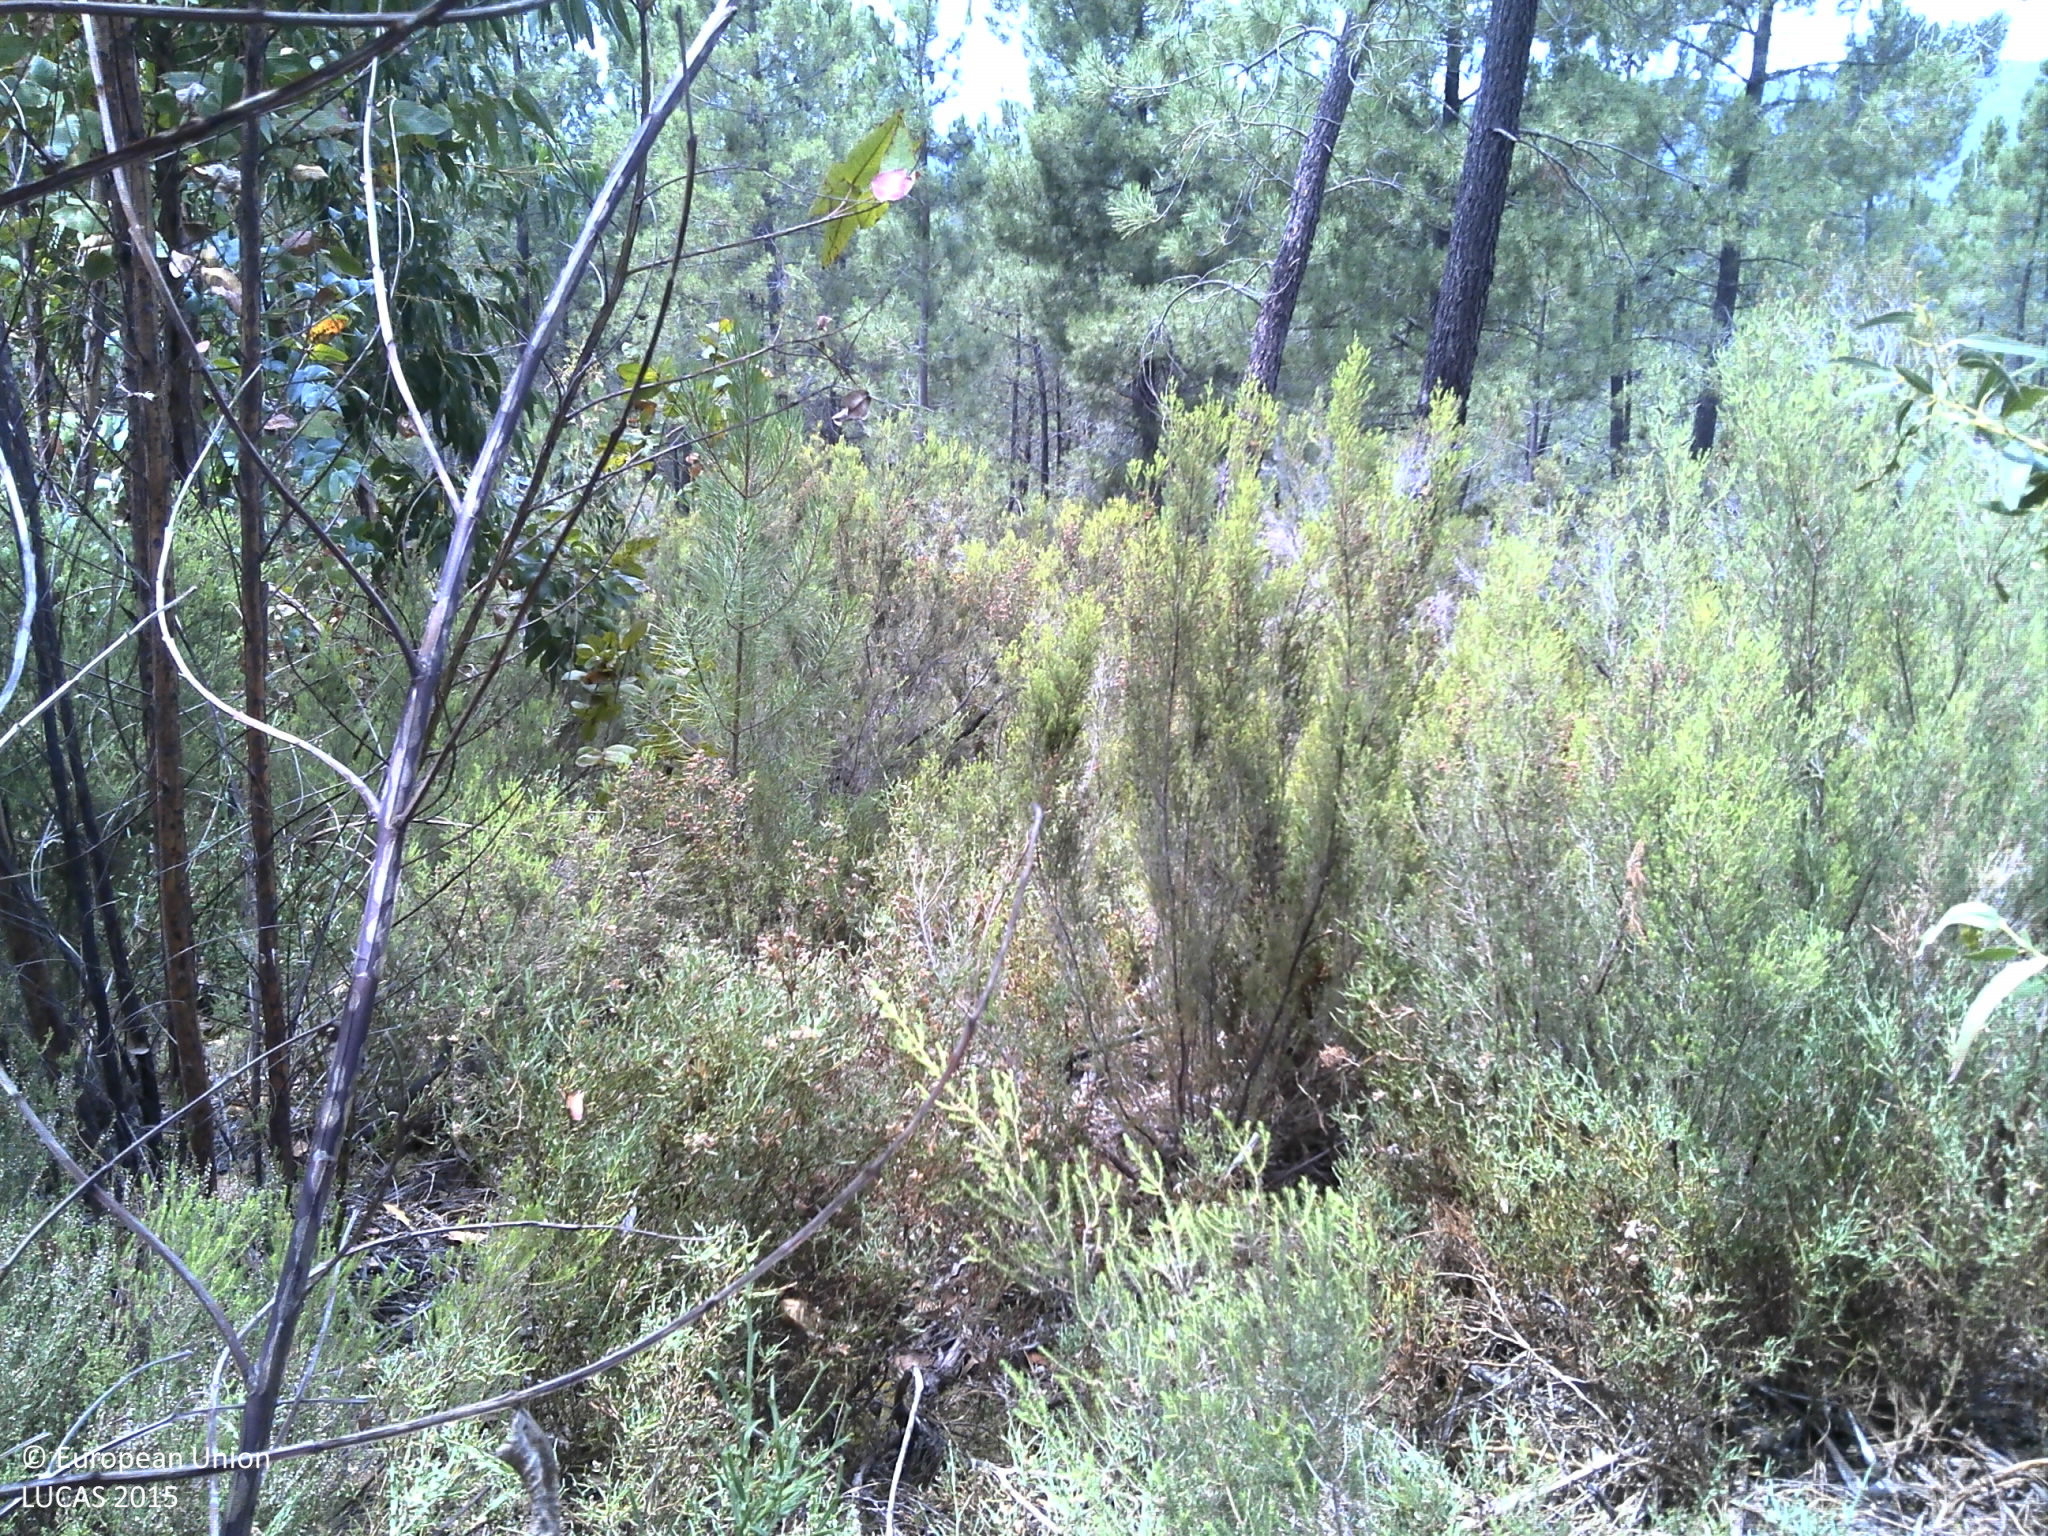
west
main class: Woodland
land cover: Pine dominated coniferous woodland
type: coniferous forest of the mediterranean region
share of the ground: 25 - 50 %
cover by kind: shrubs 50 %, coniferous forest trees 30 %, unconsolidated bare surface 20 %
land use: Forestry
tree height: > 5 m
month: July
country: PT
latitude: 39.9034
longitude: -7.8776
